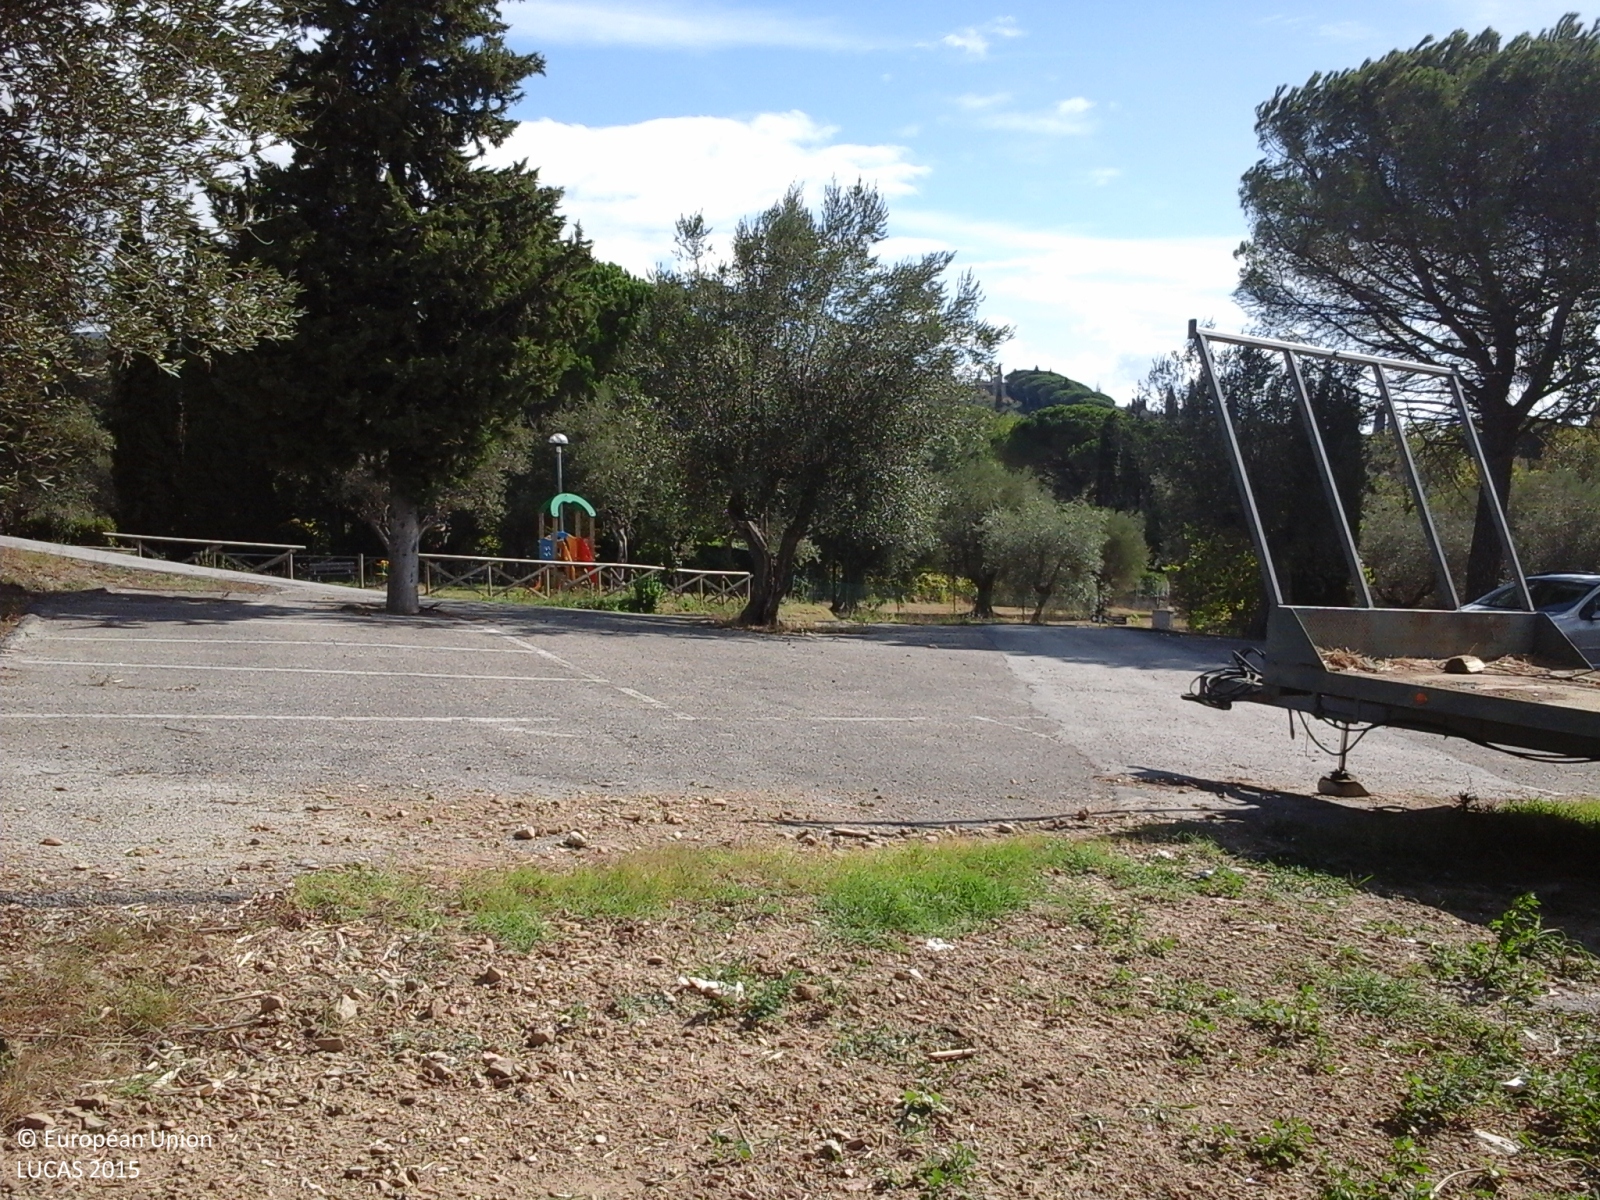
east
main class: Cropland
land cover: Olive groves
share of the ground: 50 - 75 %
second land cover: Spontaneously vegetated surfaces
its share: > 75 %
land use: Agriculture (excluding fallow land and kitchen gardens)
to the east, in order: Olive groves; Spontaneously vegetated surfaces; Lines of trees; Fences; Single bushes/trees; Artificial constructions in urban areas; Olive groves; Fences; Grass margins; Paved roads, cycling and walking lanes; Grass margins; Fences; Managed hedges; Grassland with sparse tree/shrub cover; Conifer hedges; Artificial constructions in urban areas; Olive groves; Electric lines; Conifer hedges; Grass margins; Tracks; Grass margins; Fences; Vineyards
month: September
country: IT
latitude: 43.2108
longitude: 12.0742
